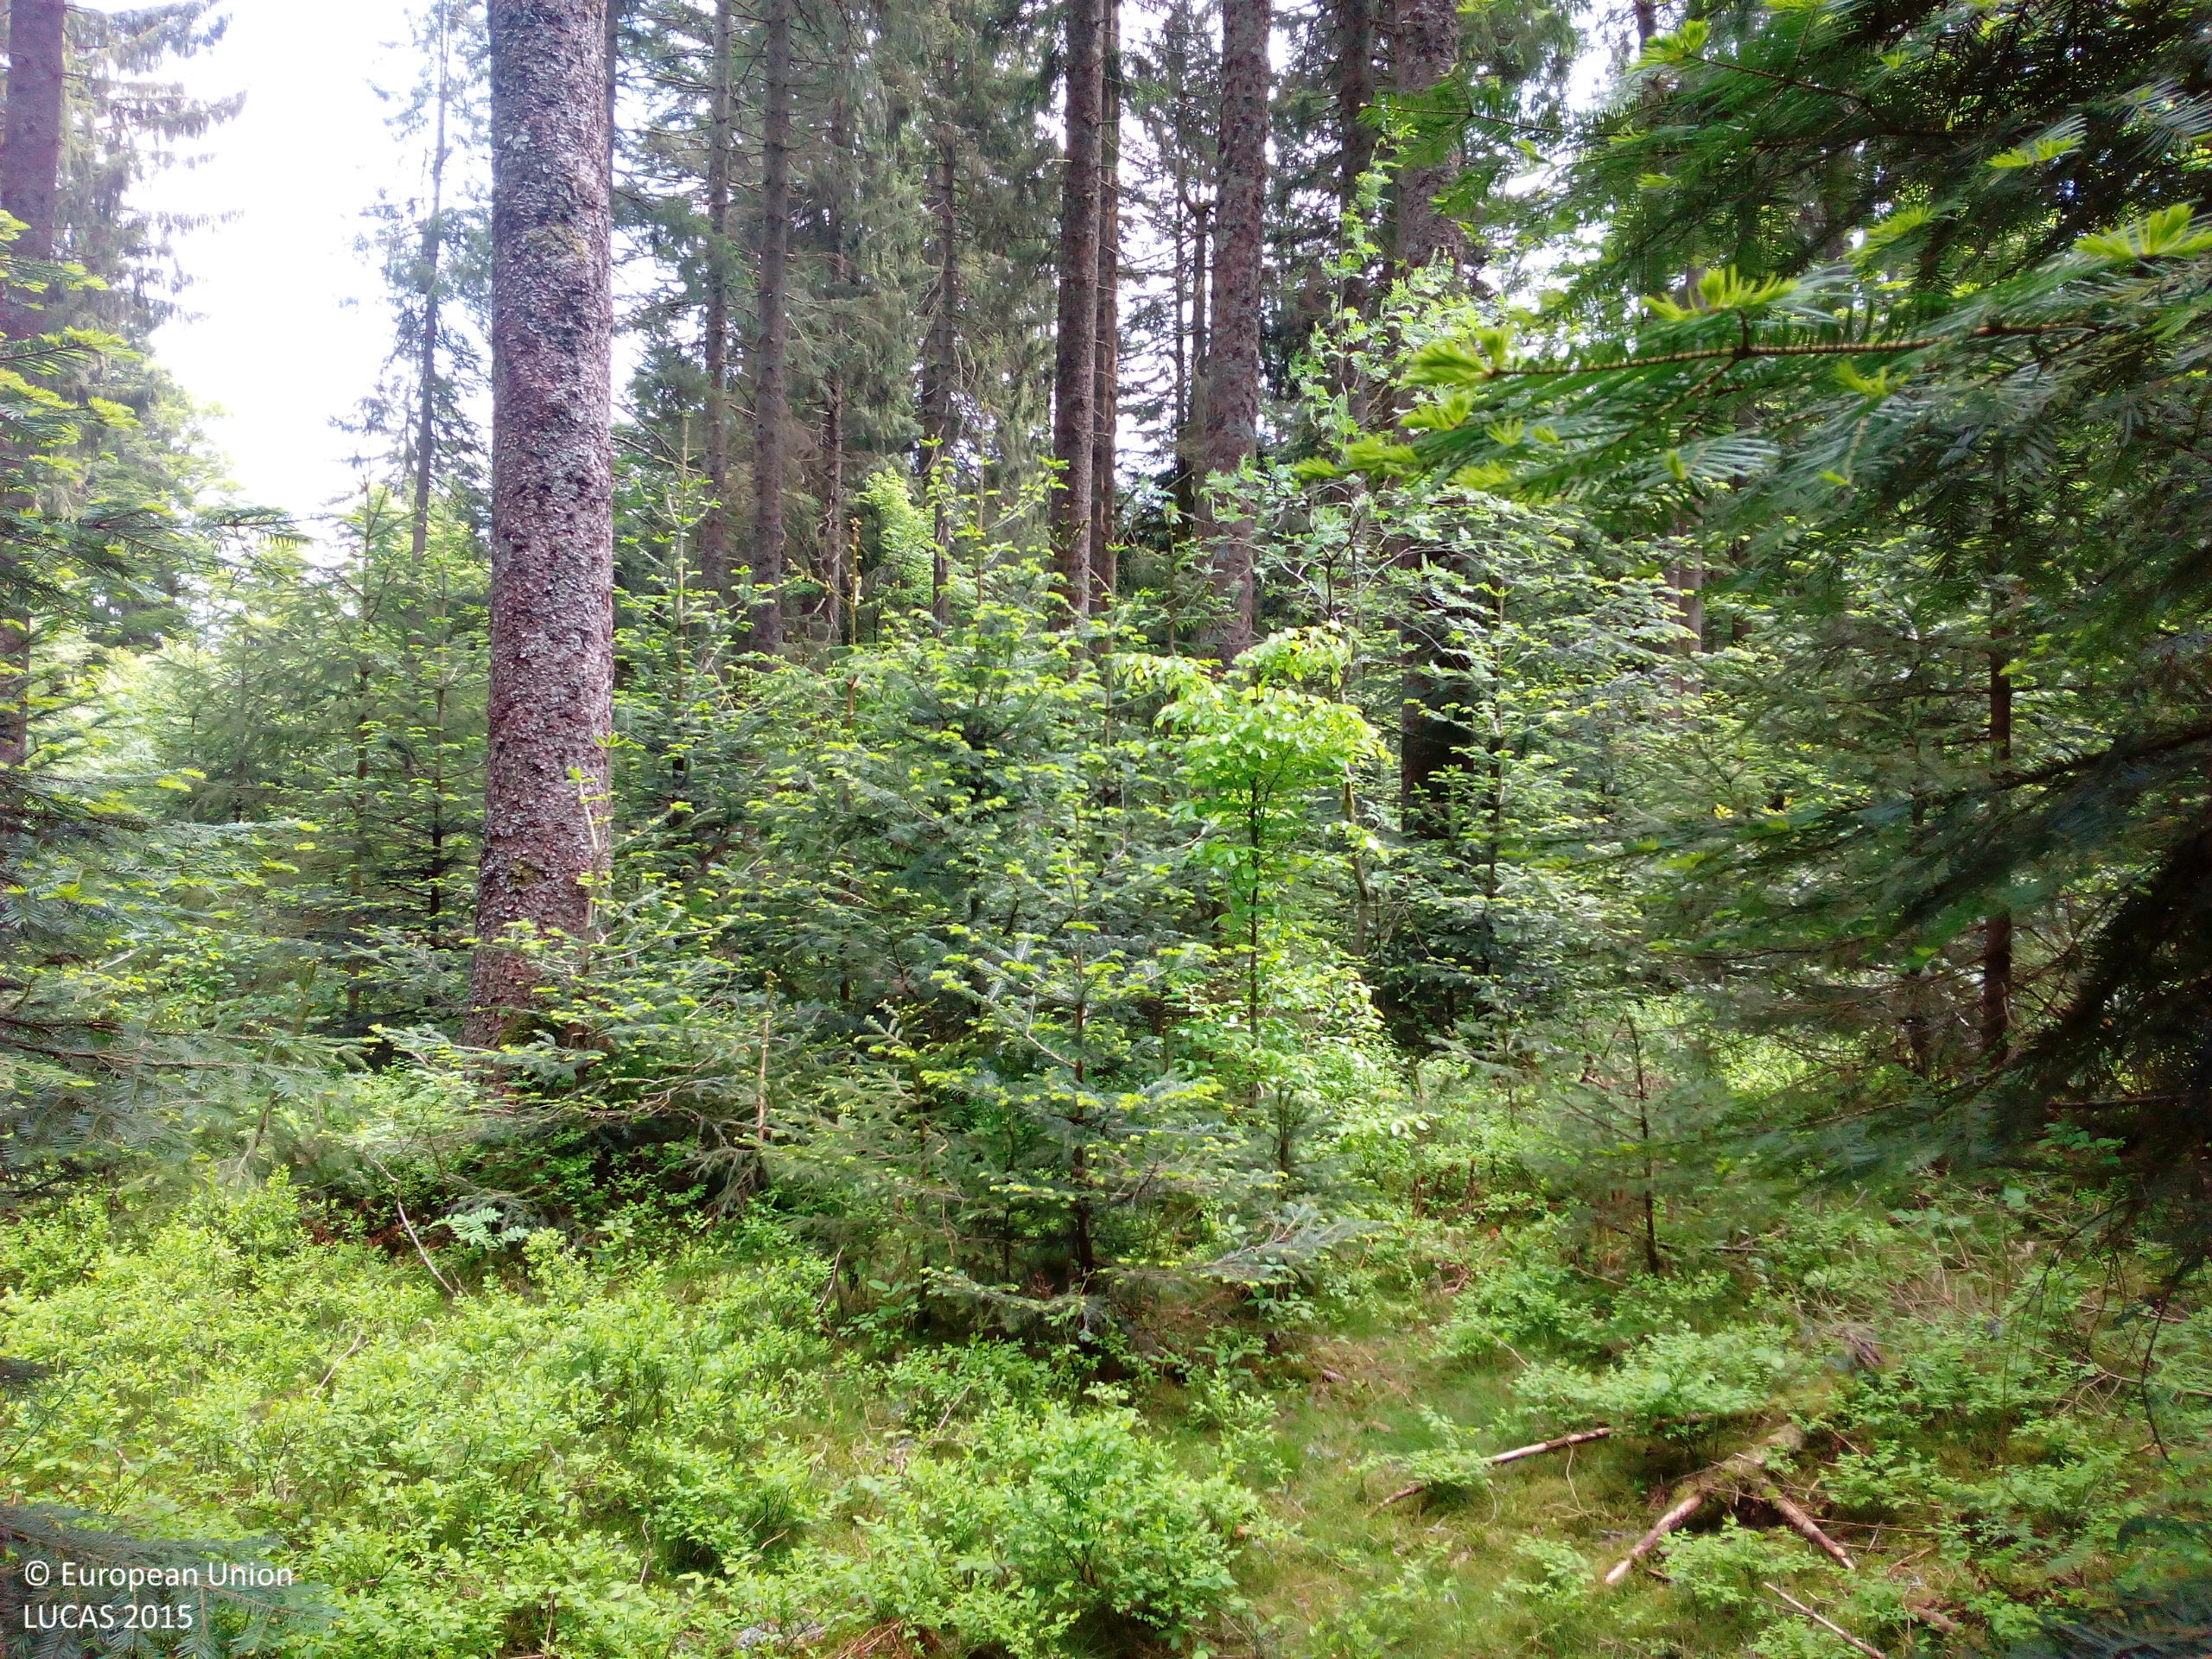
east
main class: Woodland
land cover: Other mixed woodland
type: hemiboreal forest and nemoral coniferous forest and mixed broadleaved-coniferous forest
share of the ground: > 75 %
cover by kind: coniferous forest trees 70 %, broadleaved forest trees 30 %
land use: Forestry
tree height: > 5 m
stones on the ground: < 10 %
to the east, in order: Other mixed woodland; Other coniferous woodland; Spruce dominated coniferous woodland; Other coniferous woodland; Ditches and canals; Tracks; Other coniferous woodland; Spruce dominated mixed woodland; Tracks; Other mixed woodland
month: May
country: DE
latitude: 47.9918
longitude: 8.1384
